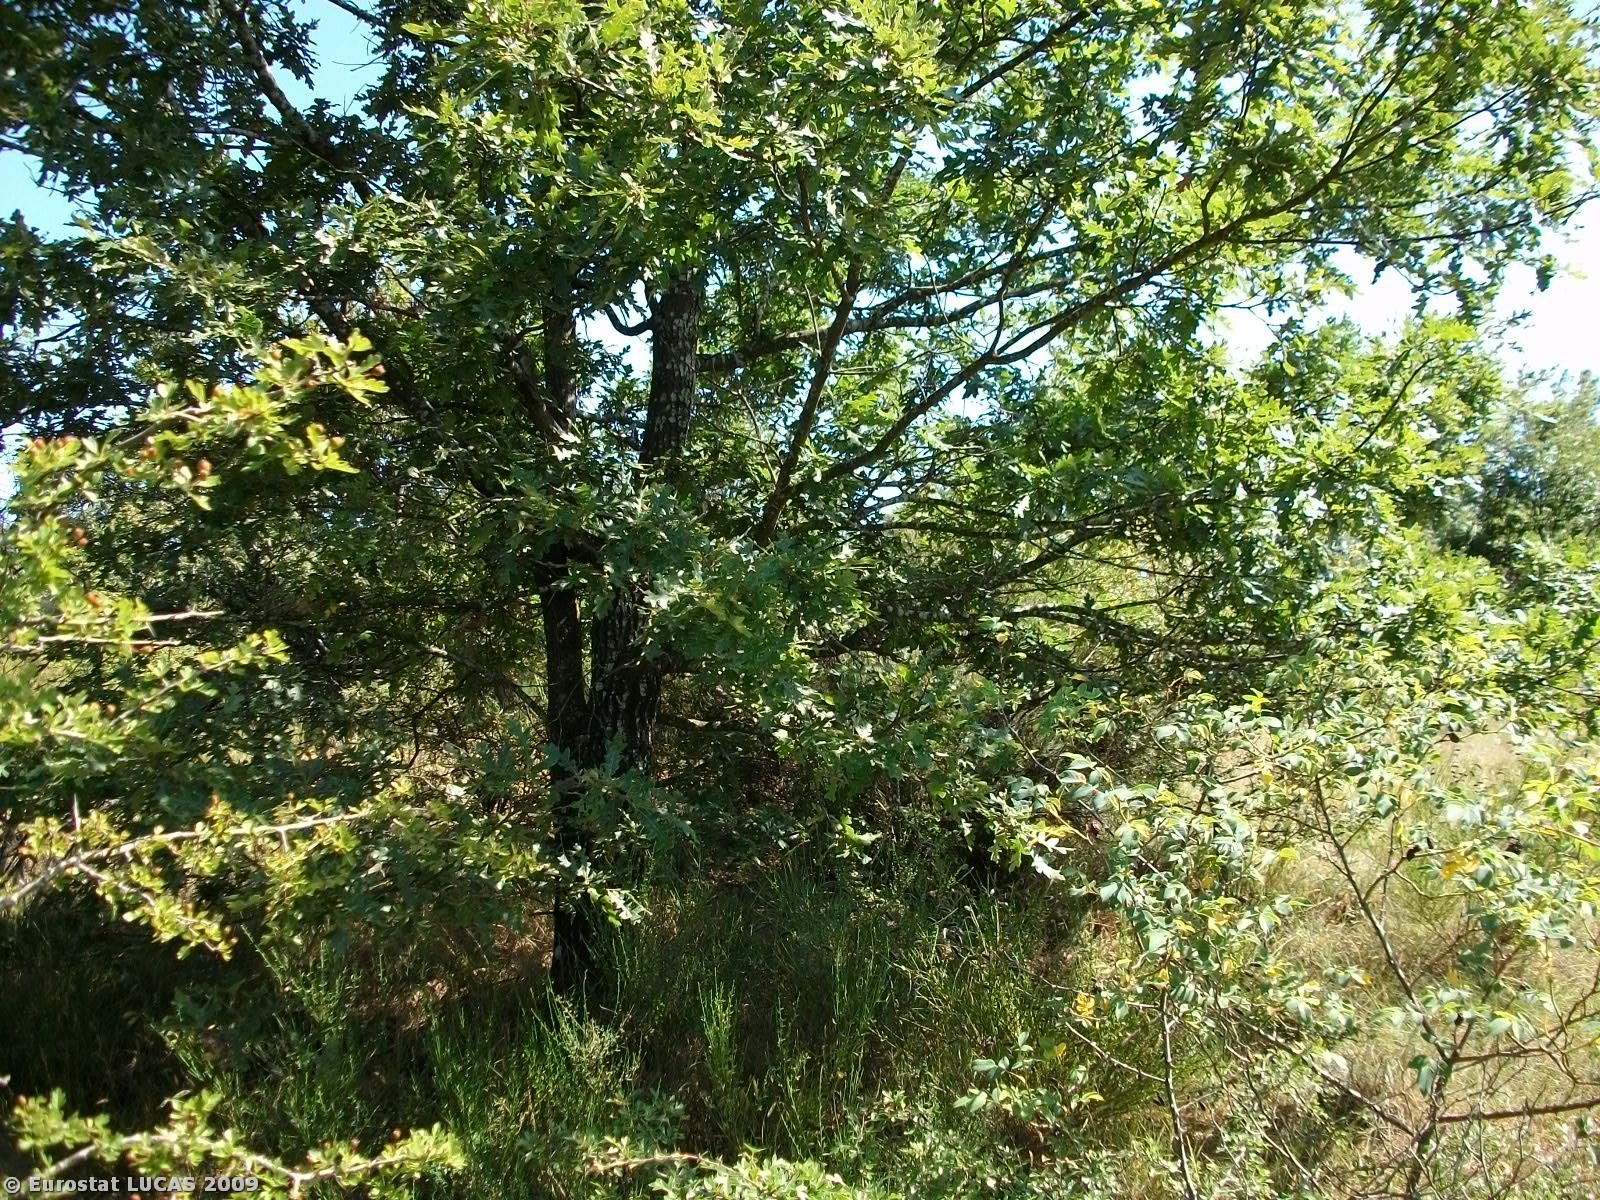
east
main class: Shrubland
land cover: Shrubland with sparse tree cover
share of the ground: > 75 %
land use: Nature reserves
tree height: > 5 m
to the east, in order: Shrubland with sparse tree cover; Tracks; Shrubland with sparse tree cover; Broadleaved woodland; Tracks; Broadleaved woodland
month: July
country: IT
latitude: 43.4097
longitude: 12.0566
